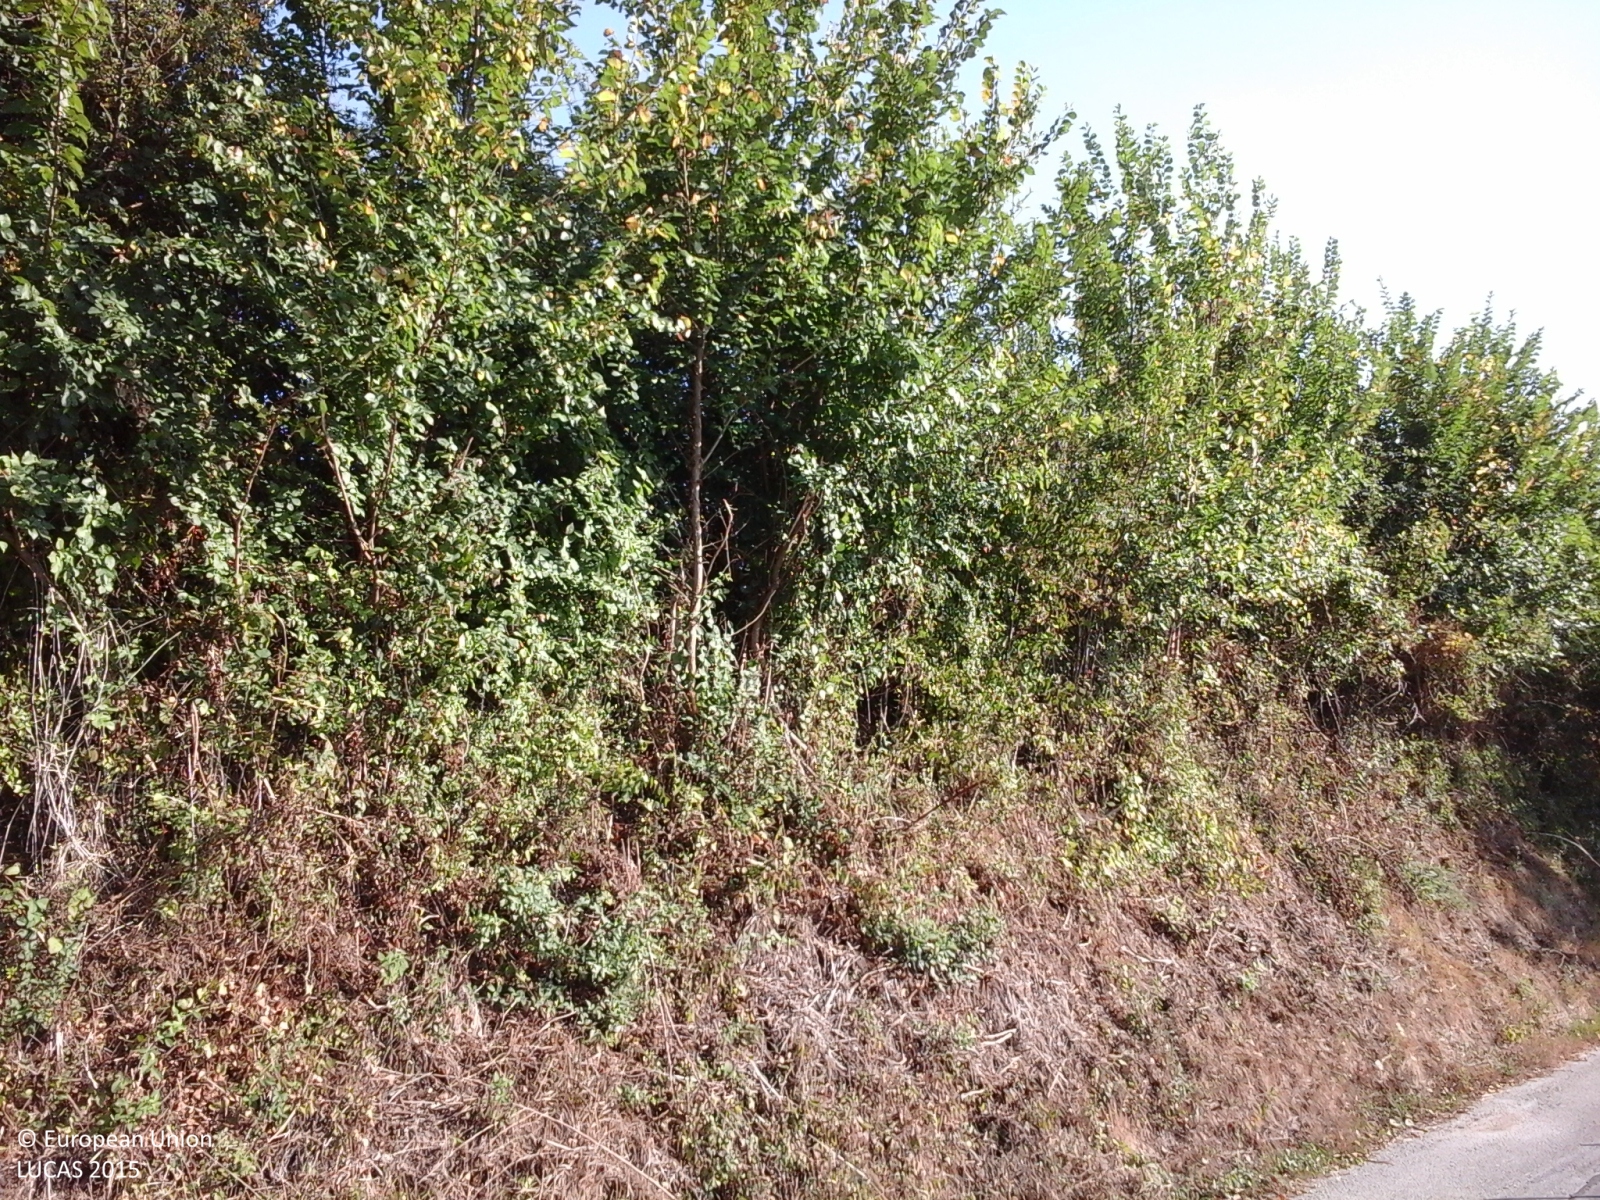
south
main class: Woodland
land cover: Broadleaved woodland
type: thermophilous deciduous forest
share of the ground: > 75 %
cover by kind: broadleaved forest trees 85 %, shrubs 10 %, herbaceous plants 5 %
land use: Semi-natural and natural areas not in use
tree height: > 5 m
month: September
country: IT
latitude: 41.5732
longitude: 14.1705
